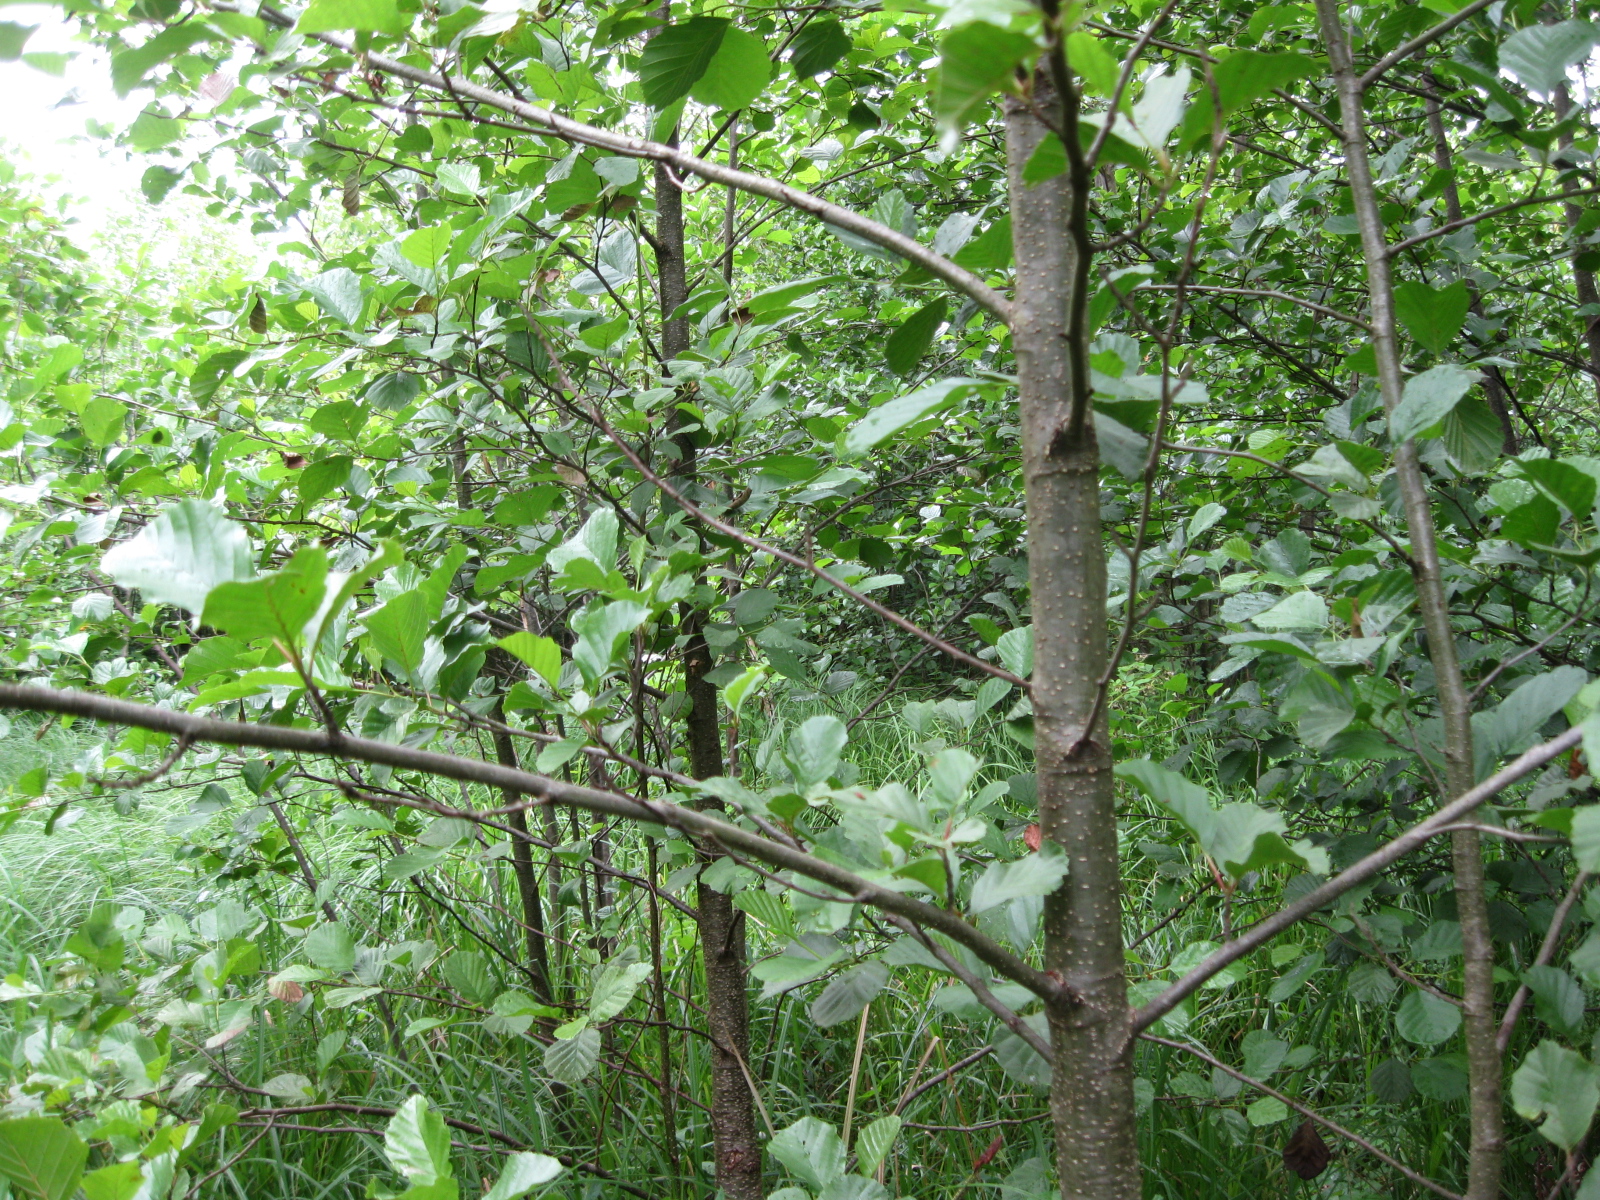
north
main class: Woodland
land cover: Broadleaved woodland
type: non-riverine alder, birch or aspen forest
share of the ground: > 75 %
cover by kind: broadleaved forest trees 80 %, herbaceous plants 15 %, shrubs 5 %
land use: Forestry
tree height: < 5 m
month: June
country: LT
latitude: 55.1016
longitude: 24.0240
